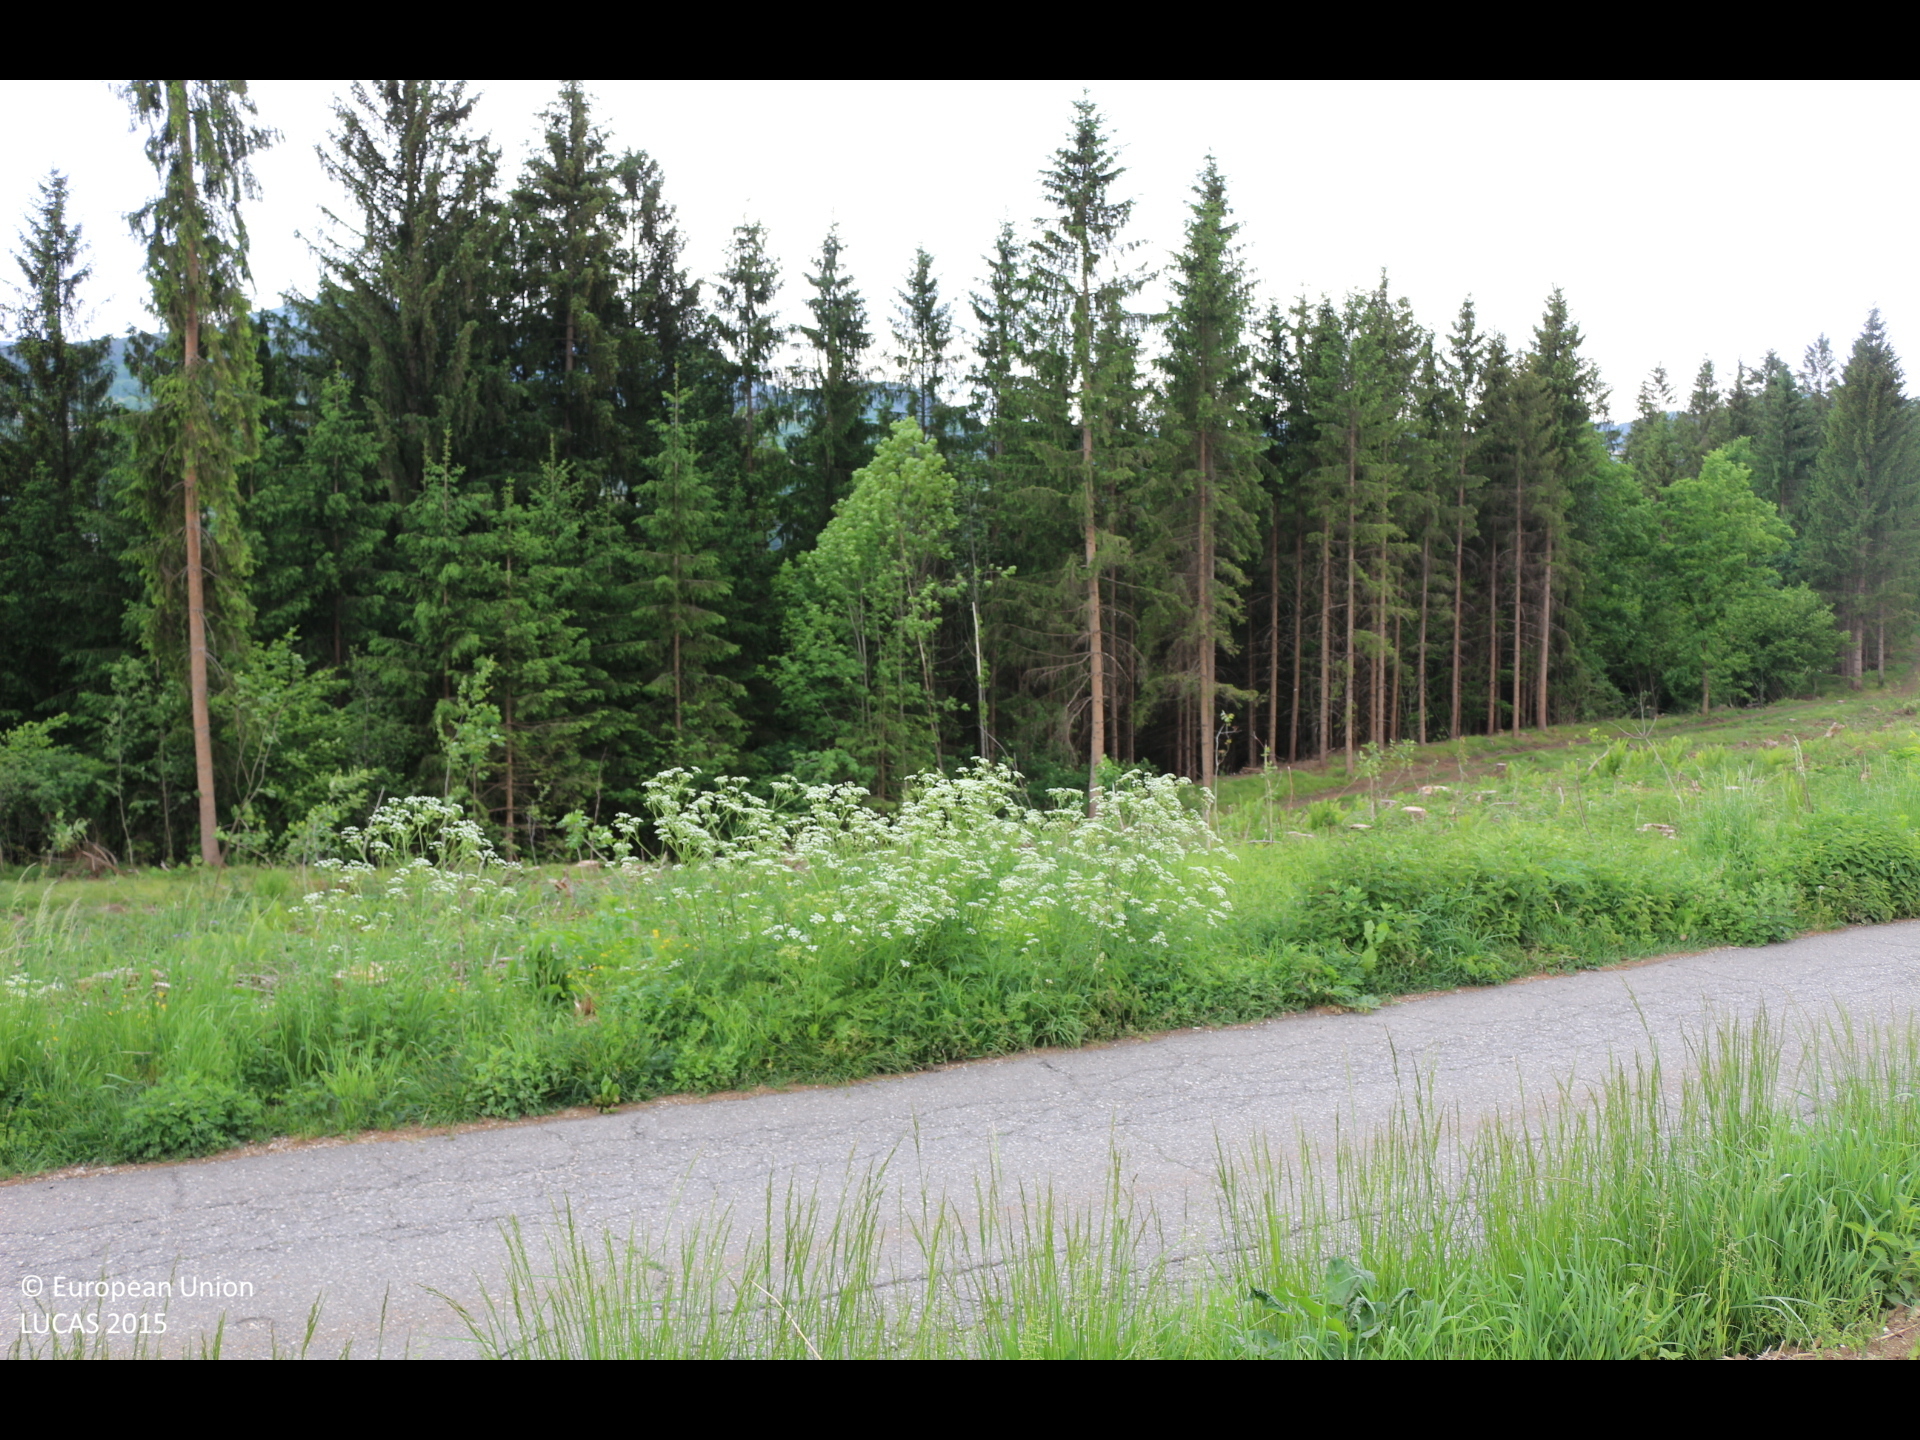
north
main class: Cropland
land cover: Maize
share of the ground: < 10 %
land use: Agriculture (excluding fallow land and kitchen gardens)
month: May
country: AT
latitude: 46.7187
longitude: 14.2233
